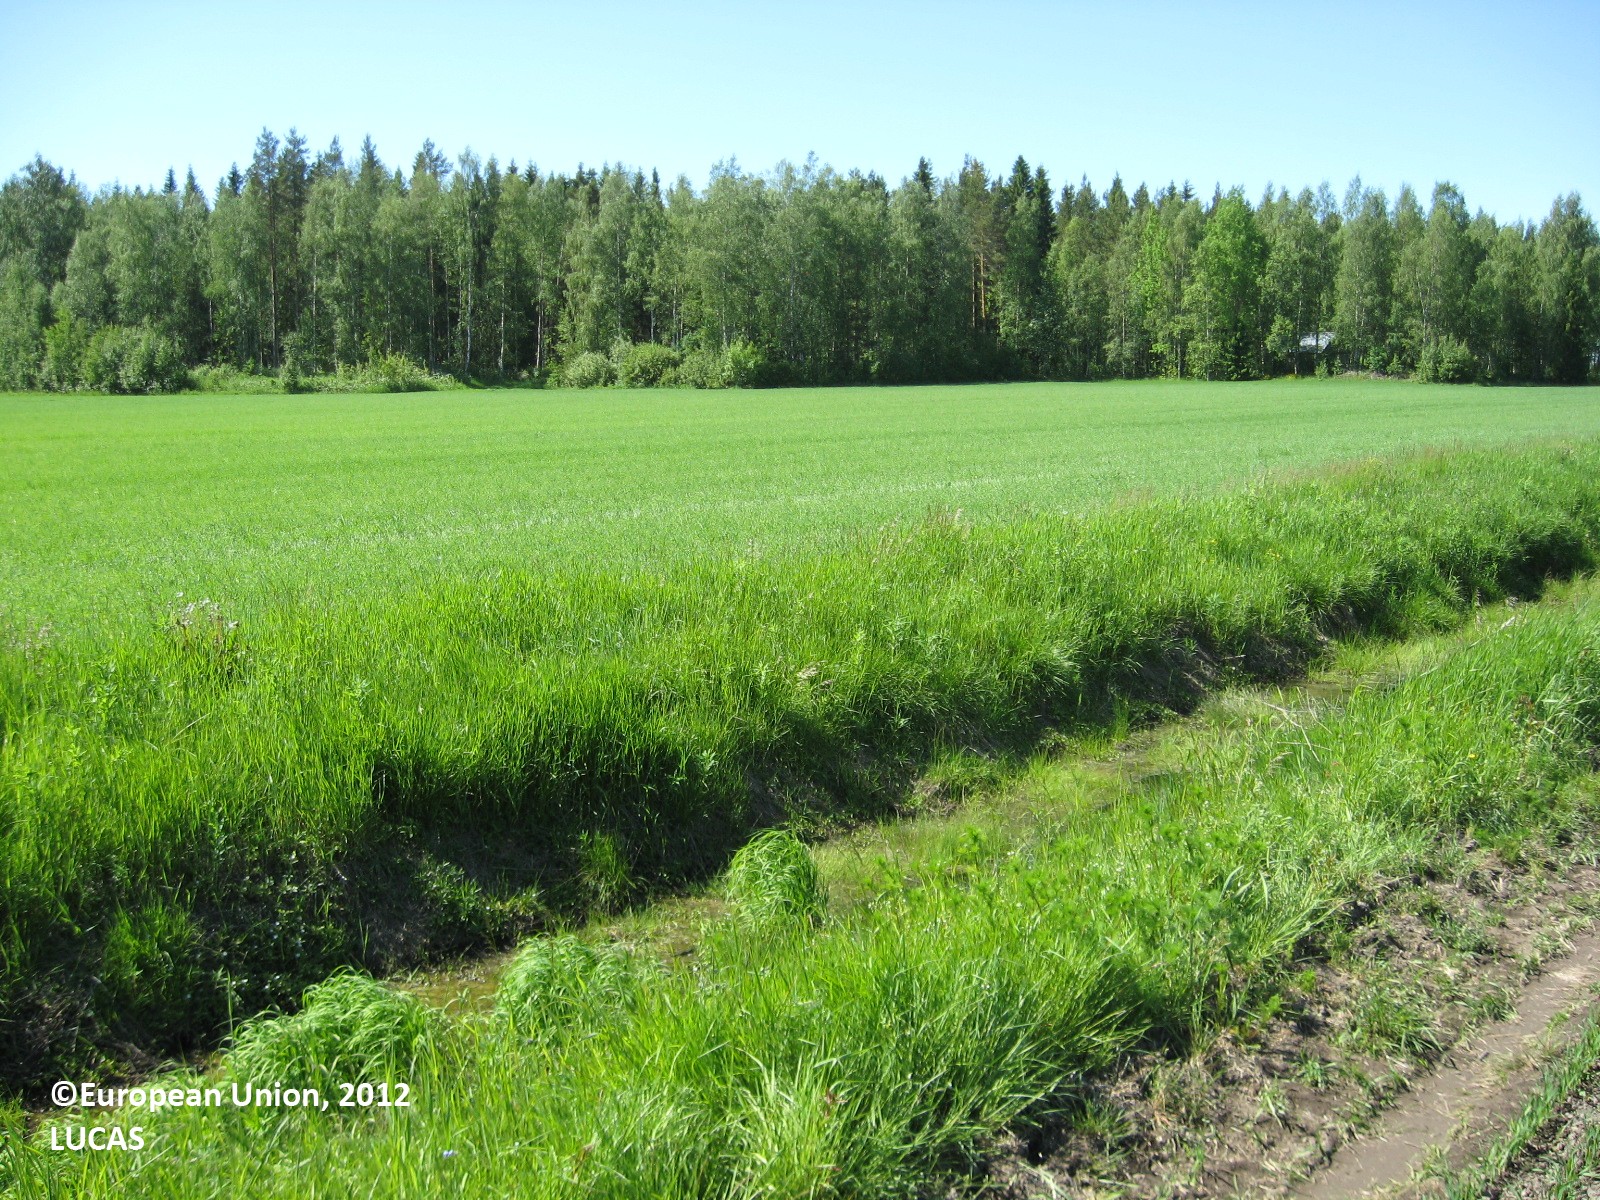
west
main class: Cropland
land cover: Oats
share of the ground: 25 - 50 %
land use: Agriculture (excluding fallow land and kitchen gardens)
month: June
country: FI
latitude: 62.9027
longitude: 21.7118
